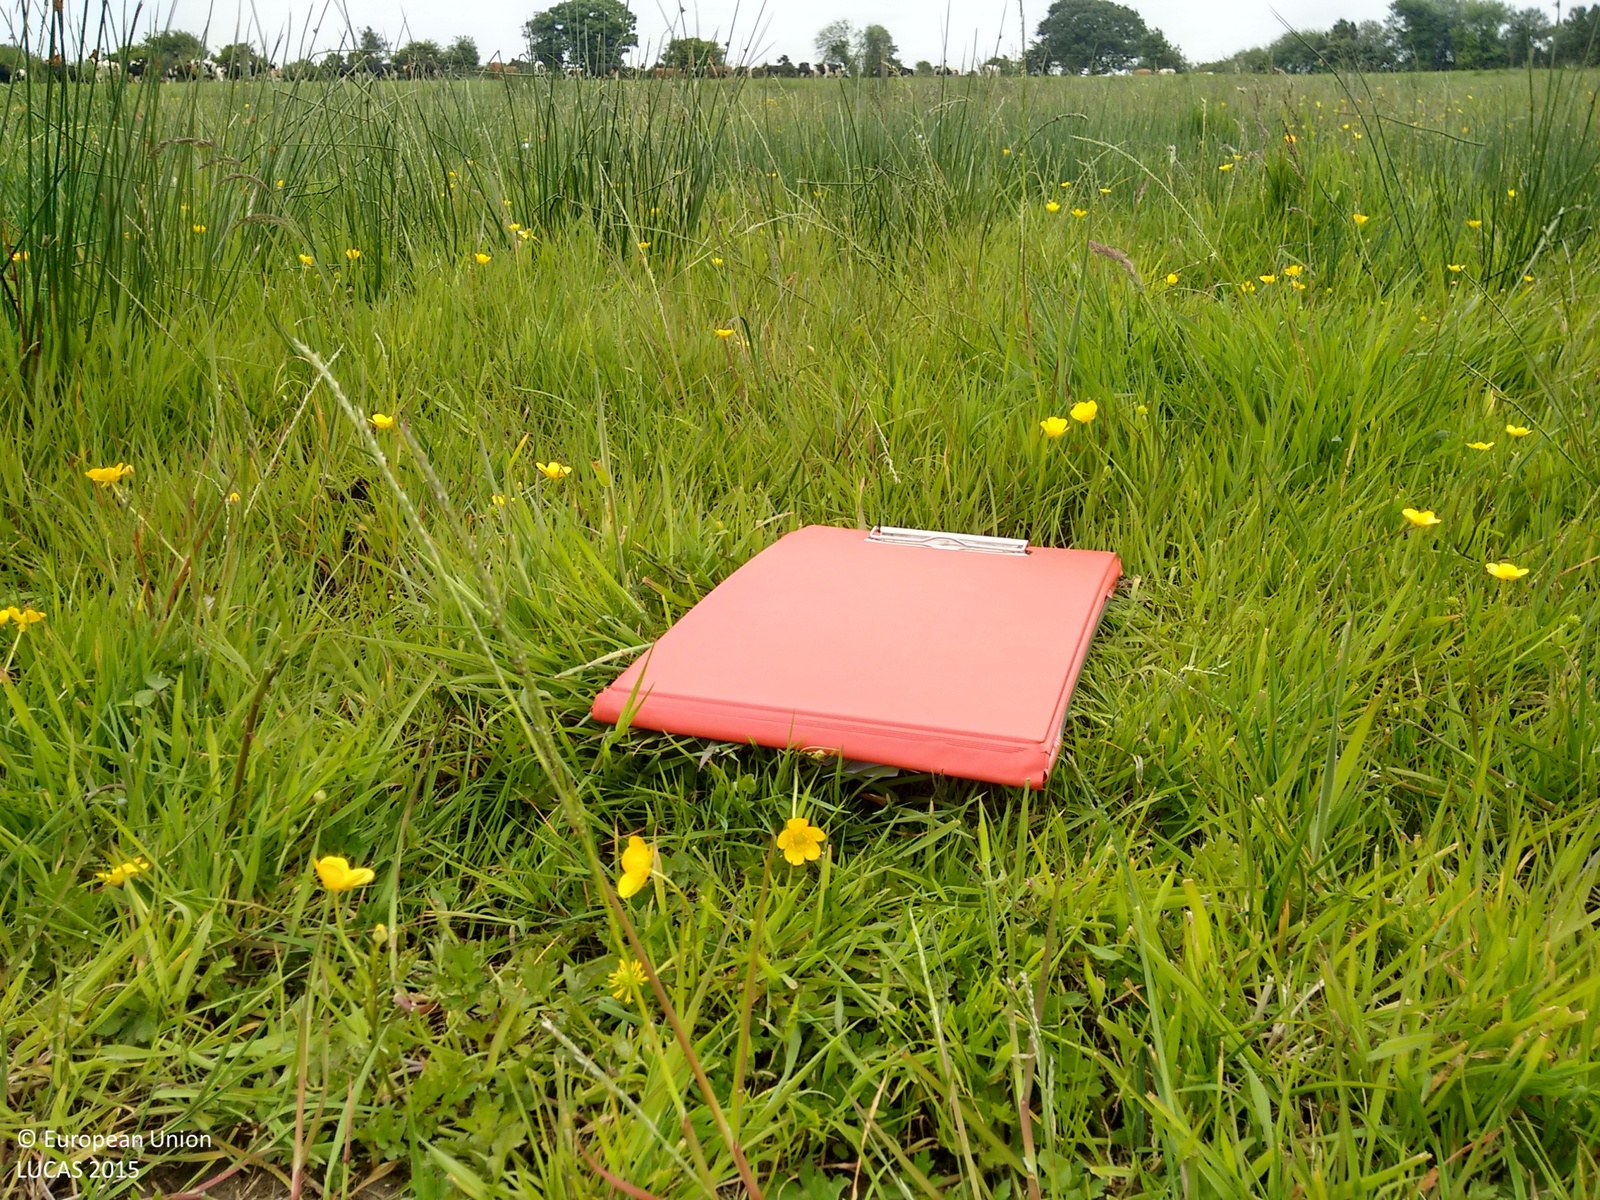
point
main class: Grassland
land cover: Grassland without tree/shrub cover
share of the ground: > 75 %
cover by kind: herbaceous plants 100 %
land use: Agriculture (excluding fallow land and kitchen gardens)
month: June
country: IE
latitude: 51.9790
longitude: -8.0112
